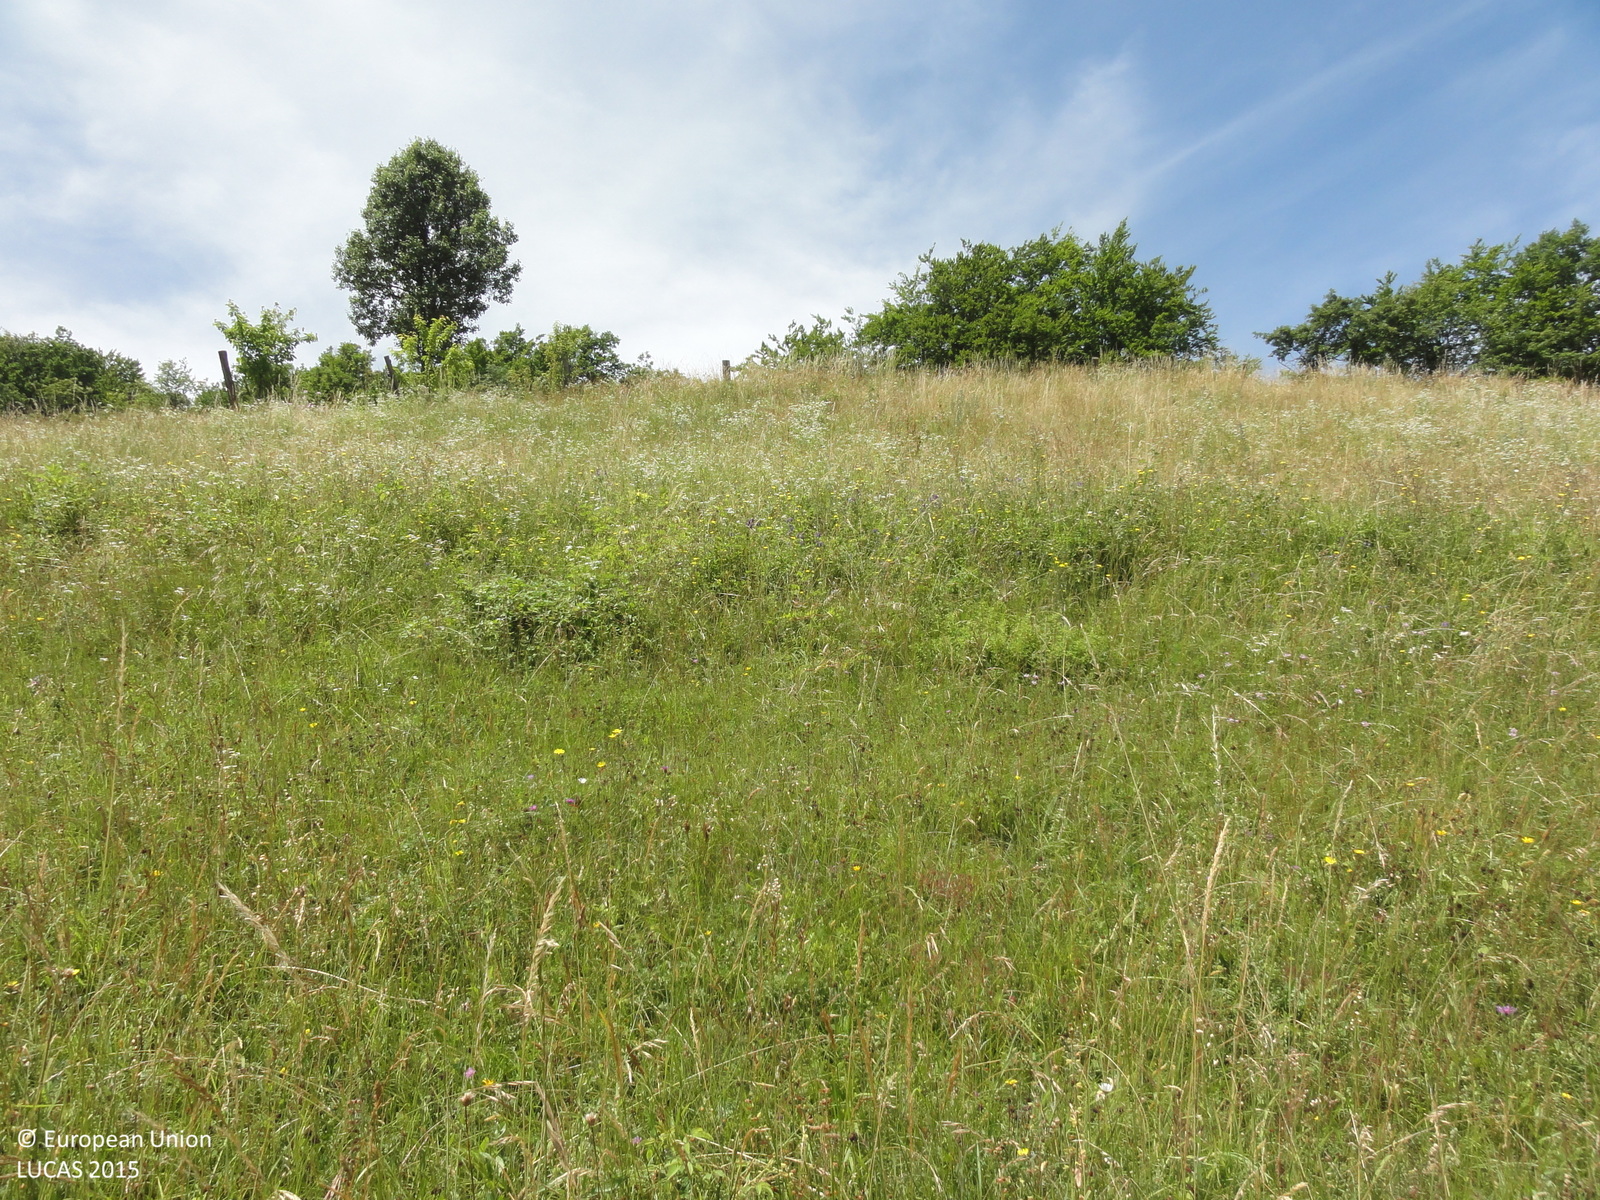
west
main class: Grassland
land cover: Grassland with sparse tree/shrub cover
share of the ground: > 75 %
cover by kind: herbaceous plants 95 %, broadleaved forest trees 5 %
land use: Agriculture (excluding fallow land and kitchen gardens)
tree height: > 5 m
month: June
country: SI
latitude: 46.2897
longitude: 15.6969
